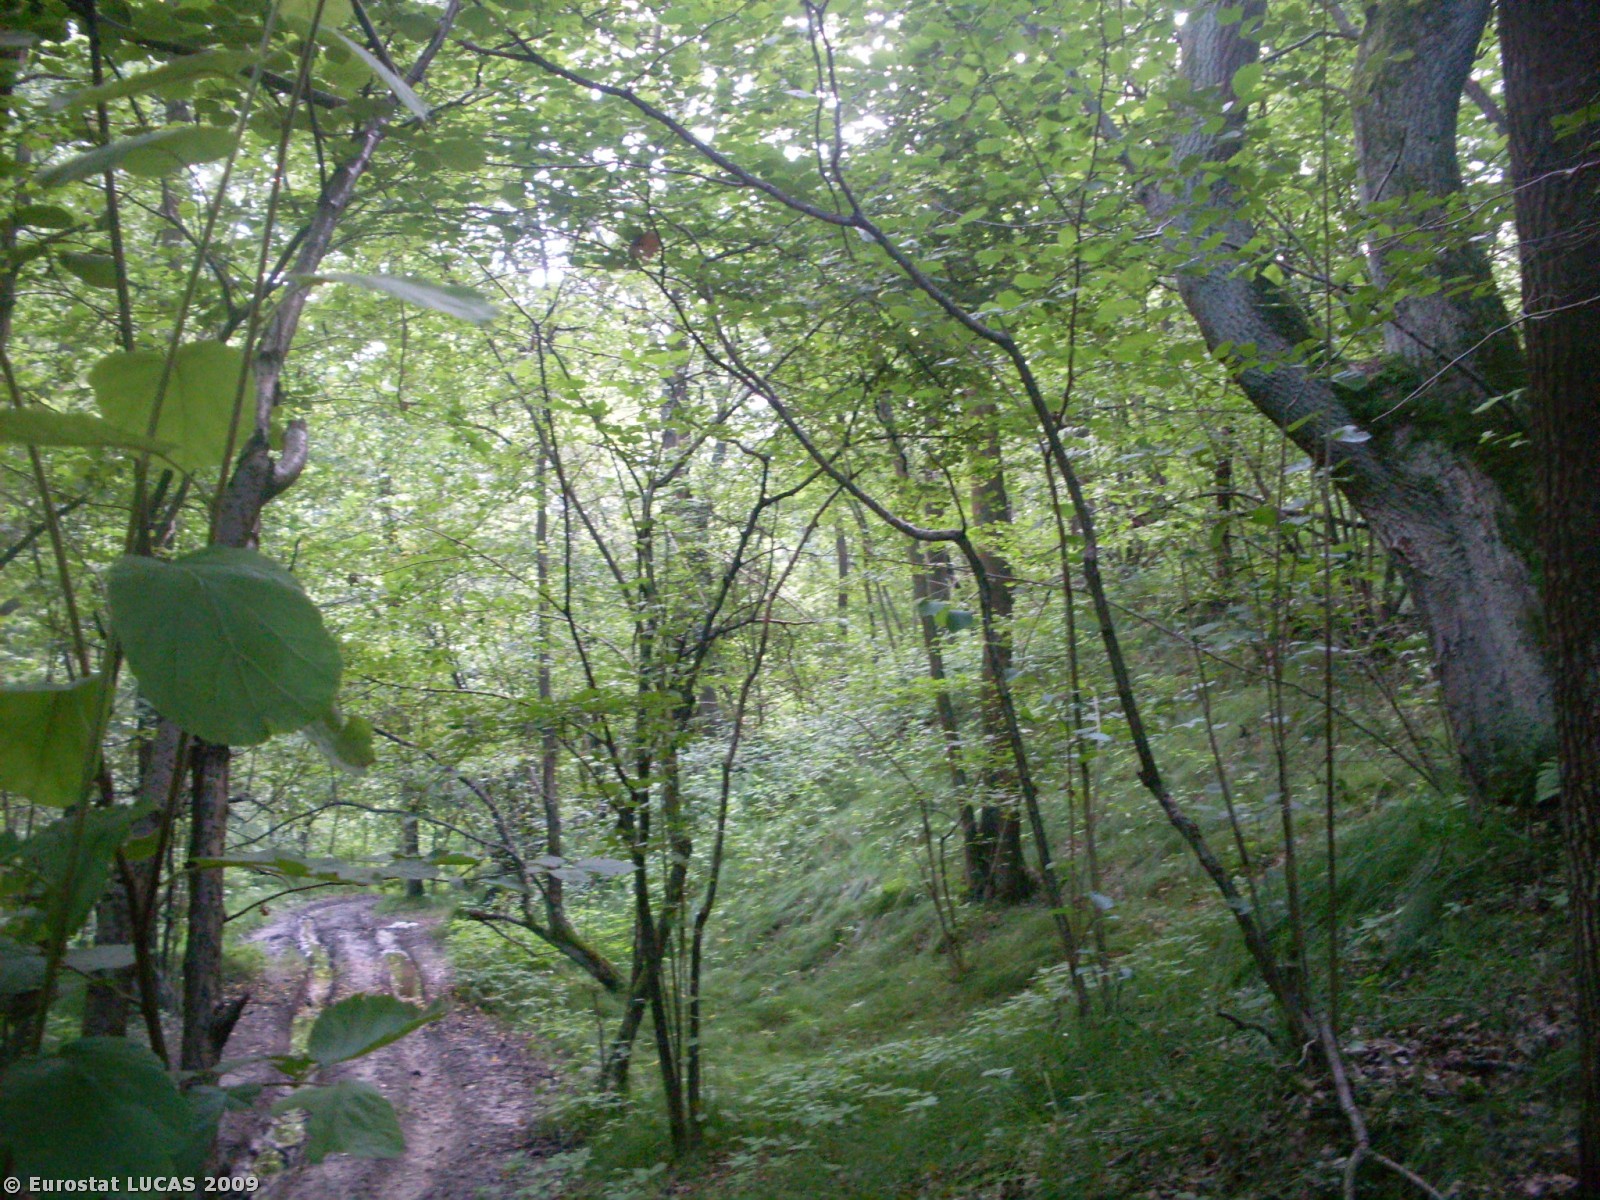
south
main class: Woodland
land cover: Broadleaved woodland
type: mesophytic deciduous forest
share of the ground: > 75 %
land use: Unused
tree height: > 5 m
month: July
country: PL
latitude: 49.9279
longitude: 19.9639
